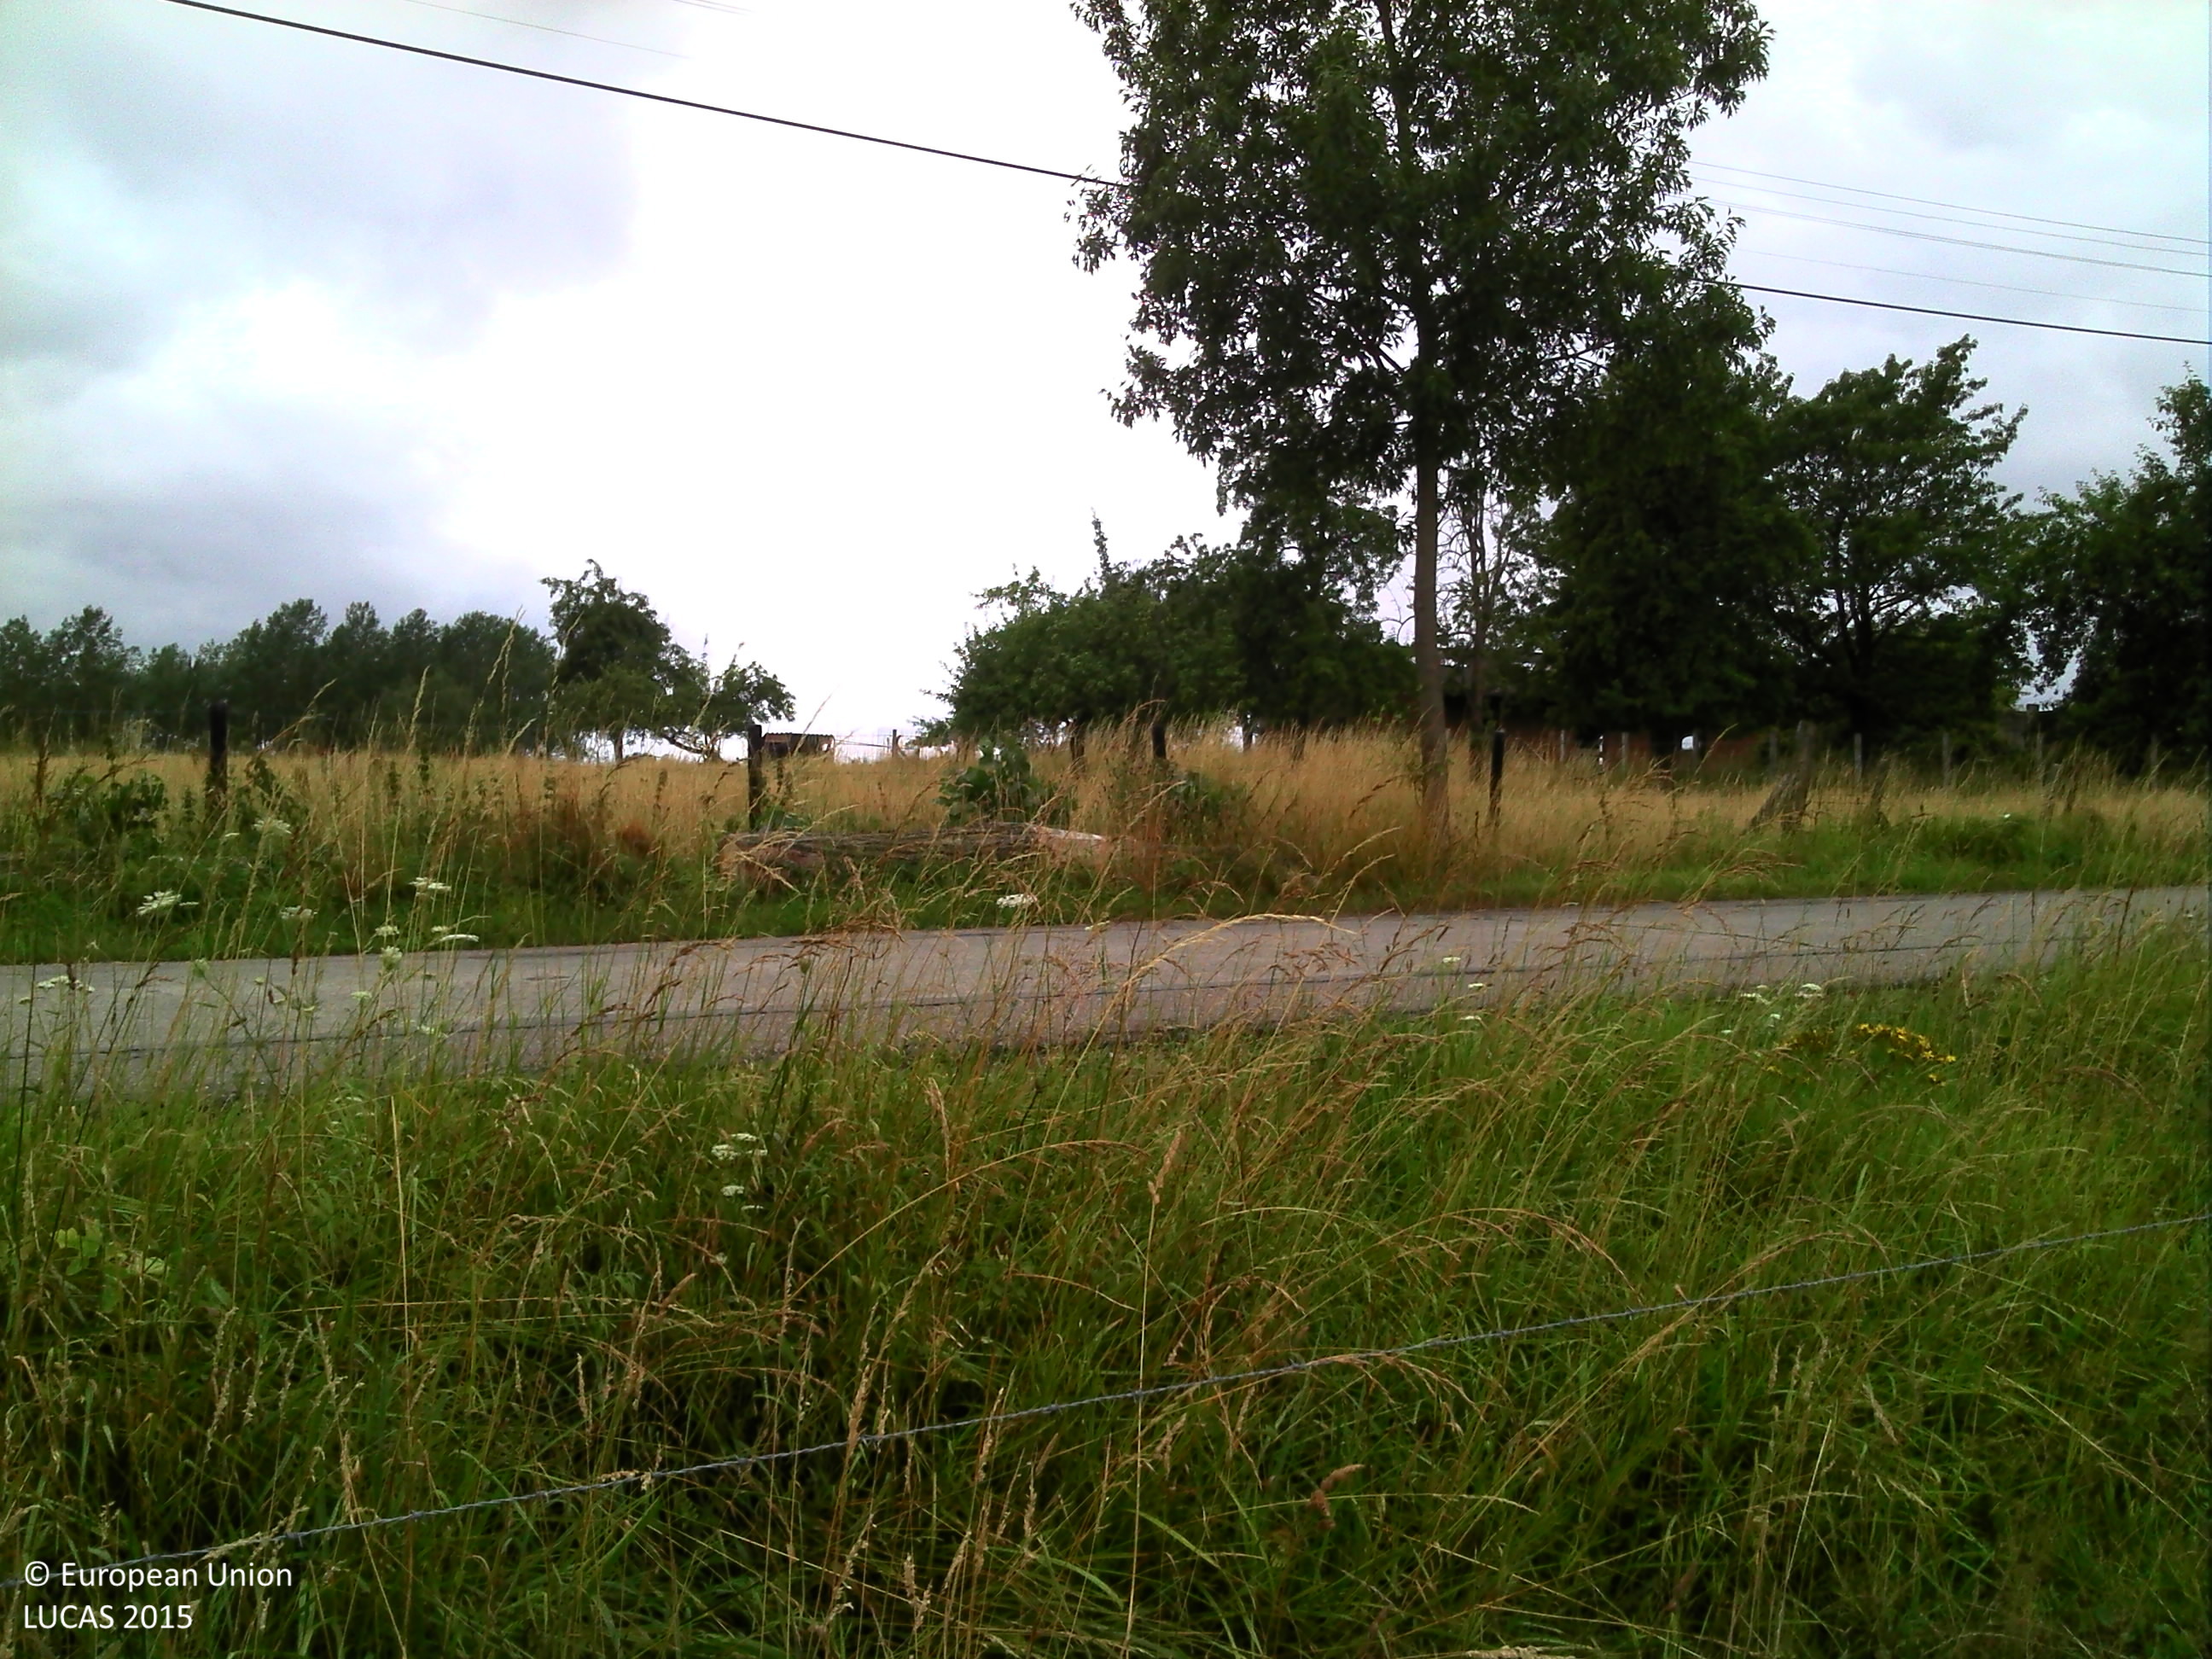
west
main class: Grassland
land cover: Grassland without tree/shrub cover
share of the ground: > 75 %
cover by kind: herbaceous plants 100 %
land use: Agriculture (excluding fallow land and kitchen gardens)
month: July
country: BE
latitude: 50.8685
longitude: 5.4653
